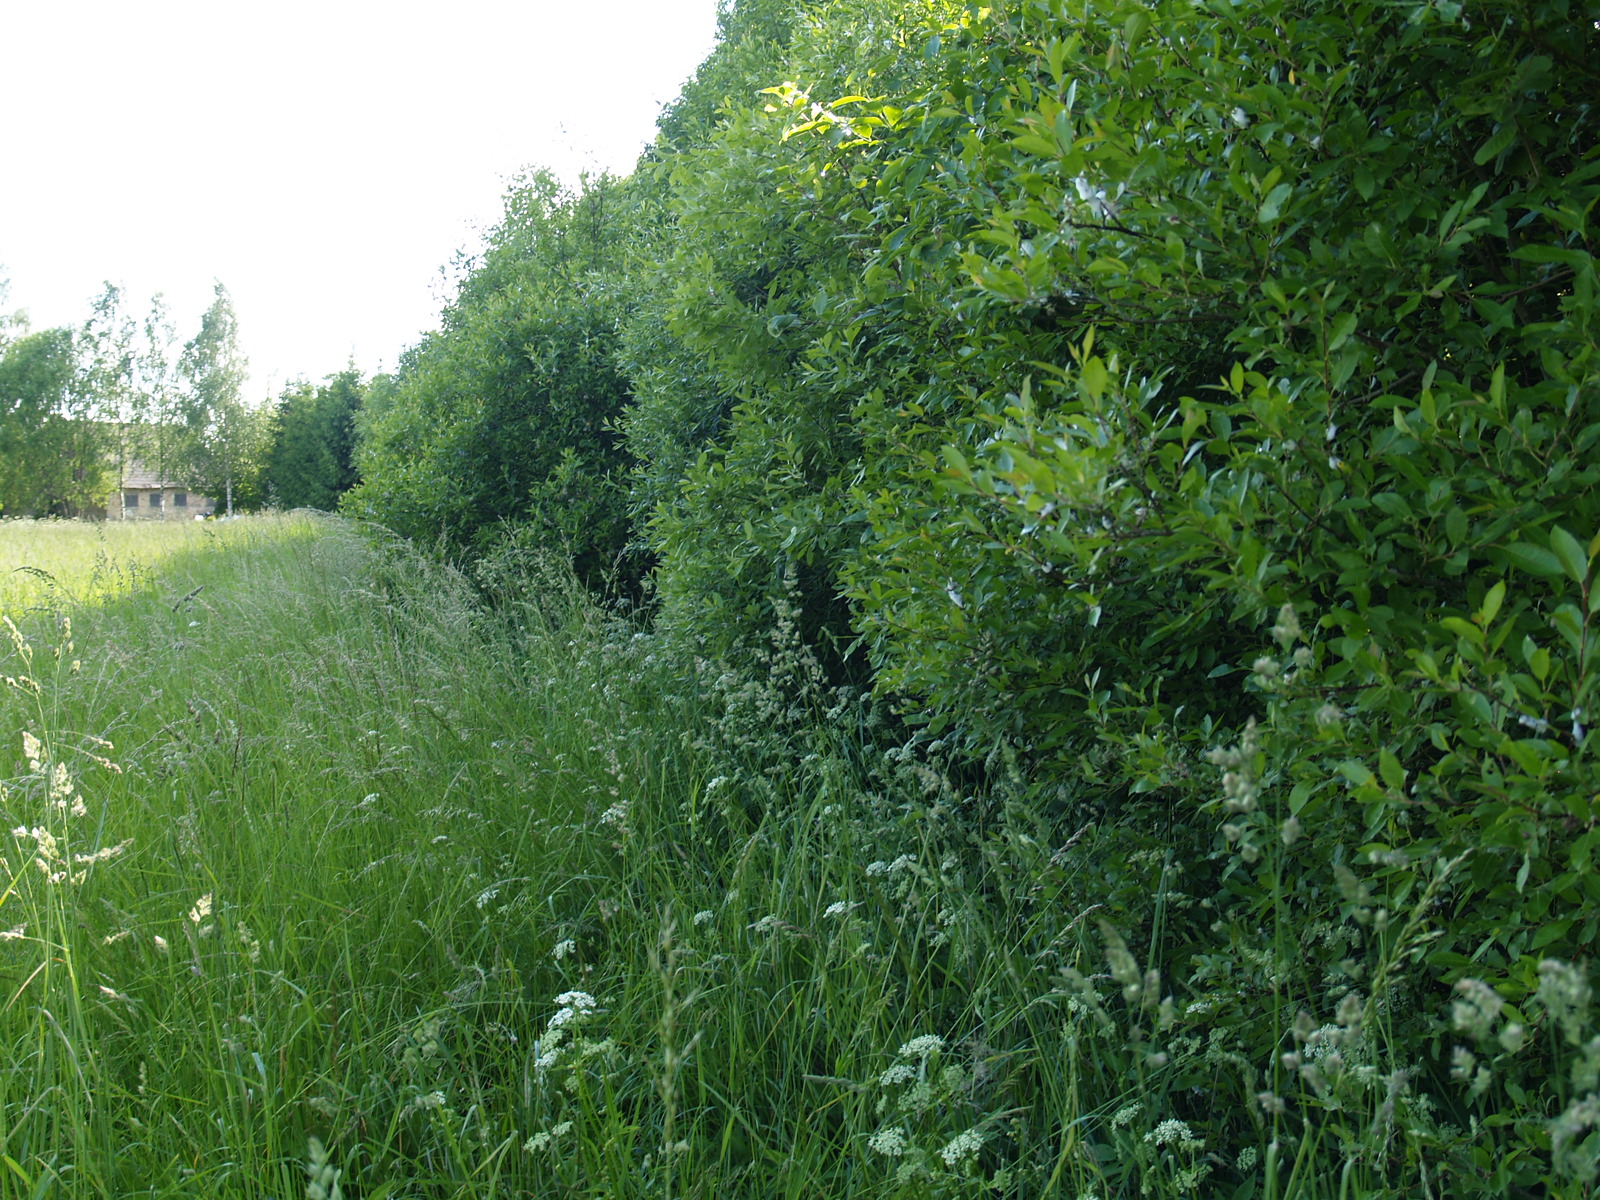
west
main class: Grassland
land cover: Grassland without tree/shrub cover
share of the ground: > 75 %
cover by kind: herbaceous plants 100 %
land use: Agriculture (excluding fallow land and kitchen gardens)
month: June
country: LV
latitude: 56.6139
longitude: 25.6520
